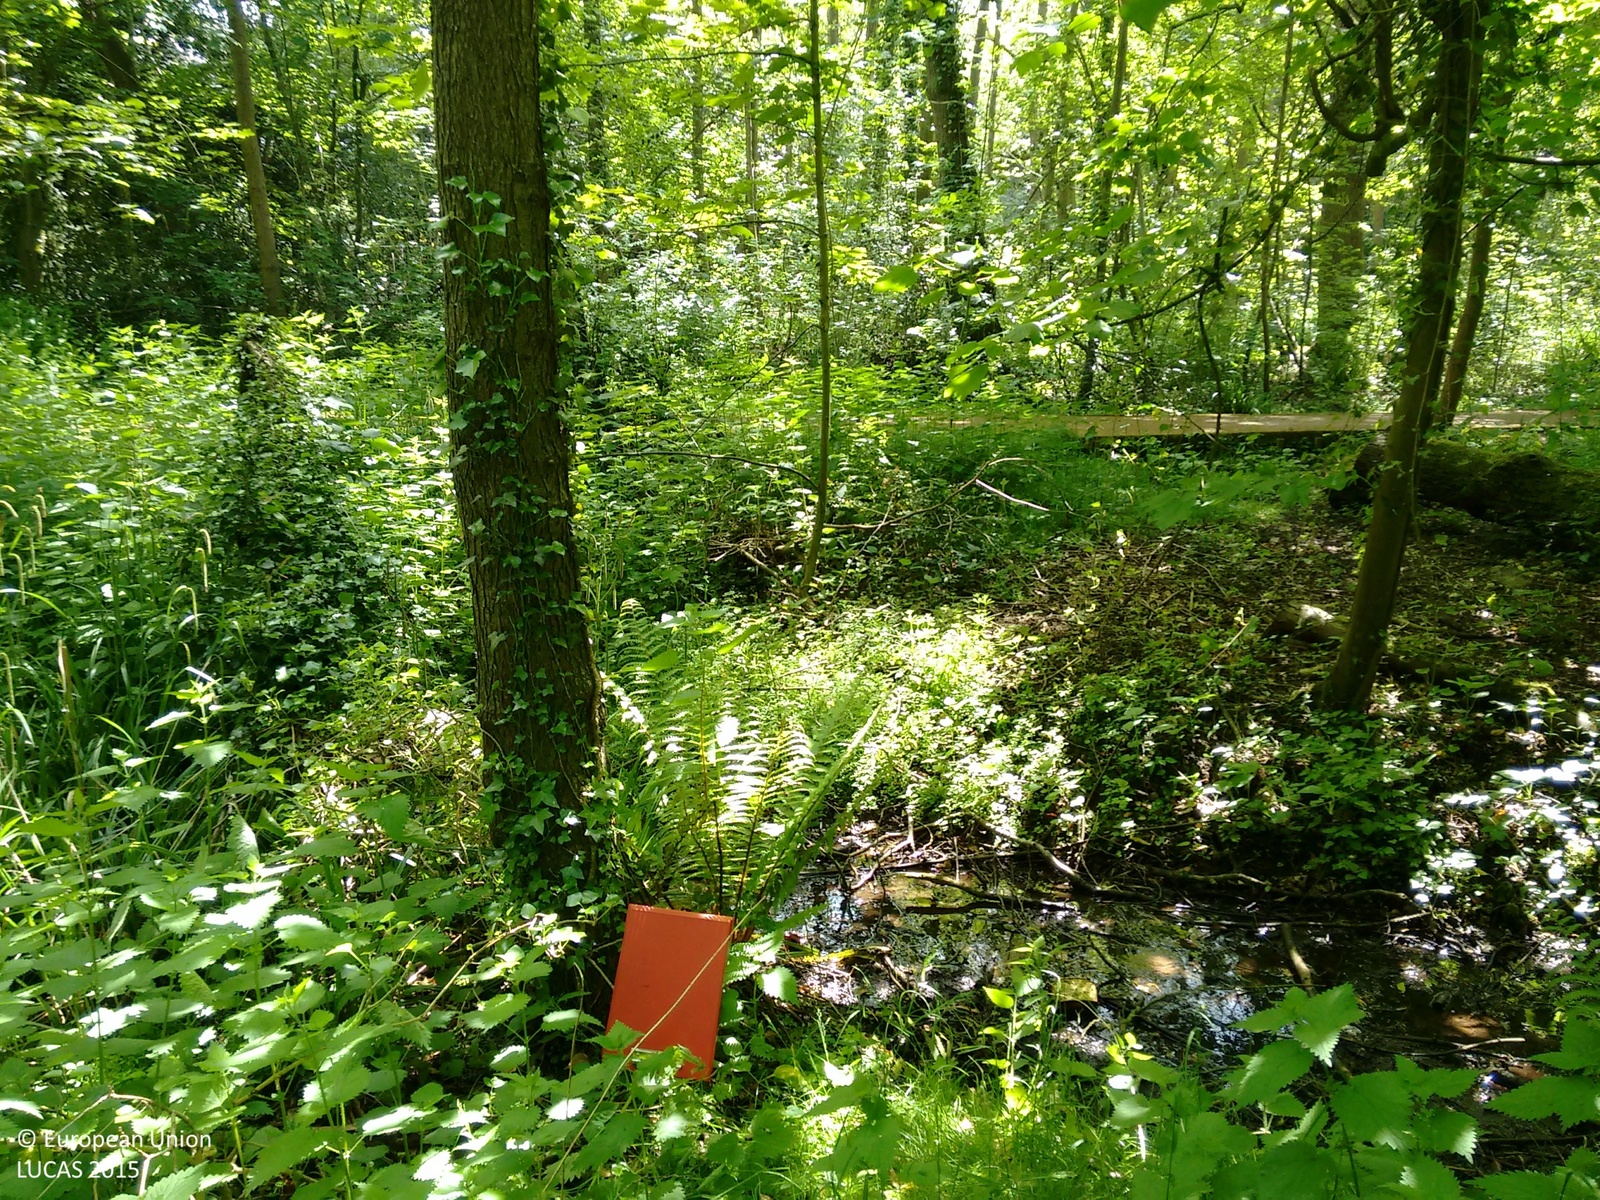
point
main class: Woodland
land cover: Broadleaved woodland
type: mesophytic deciduous forest
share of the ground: > 75 %
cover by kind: broadleaved forest trees 80 %, shrubs 10 %, herbaceous plants 10 %
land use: Amenities, museums, leisure
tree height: > 5 m
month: May
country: GB
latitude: 52.0891
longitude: -0.3257
